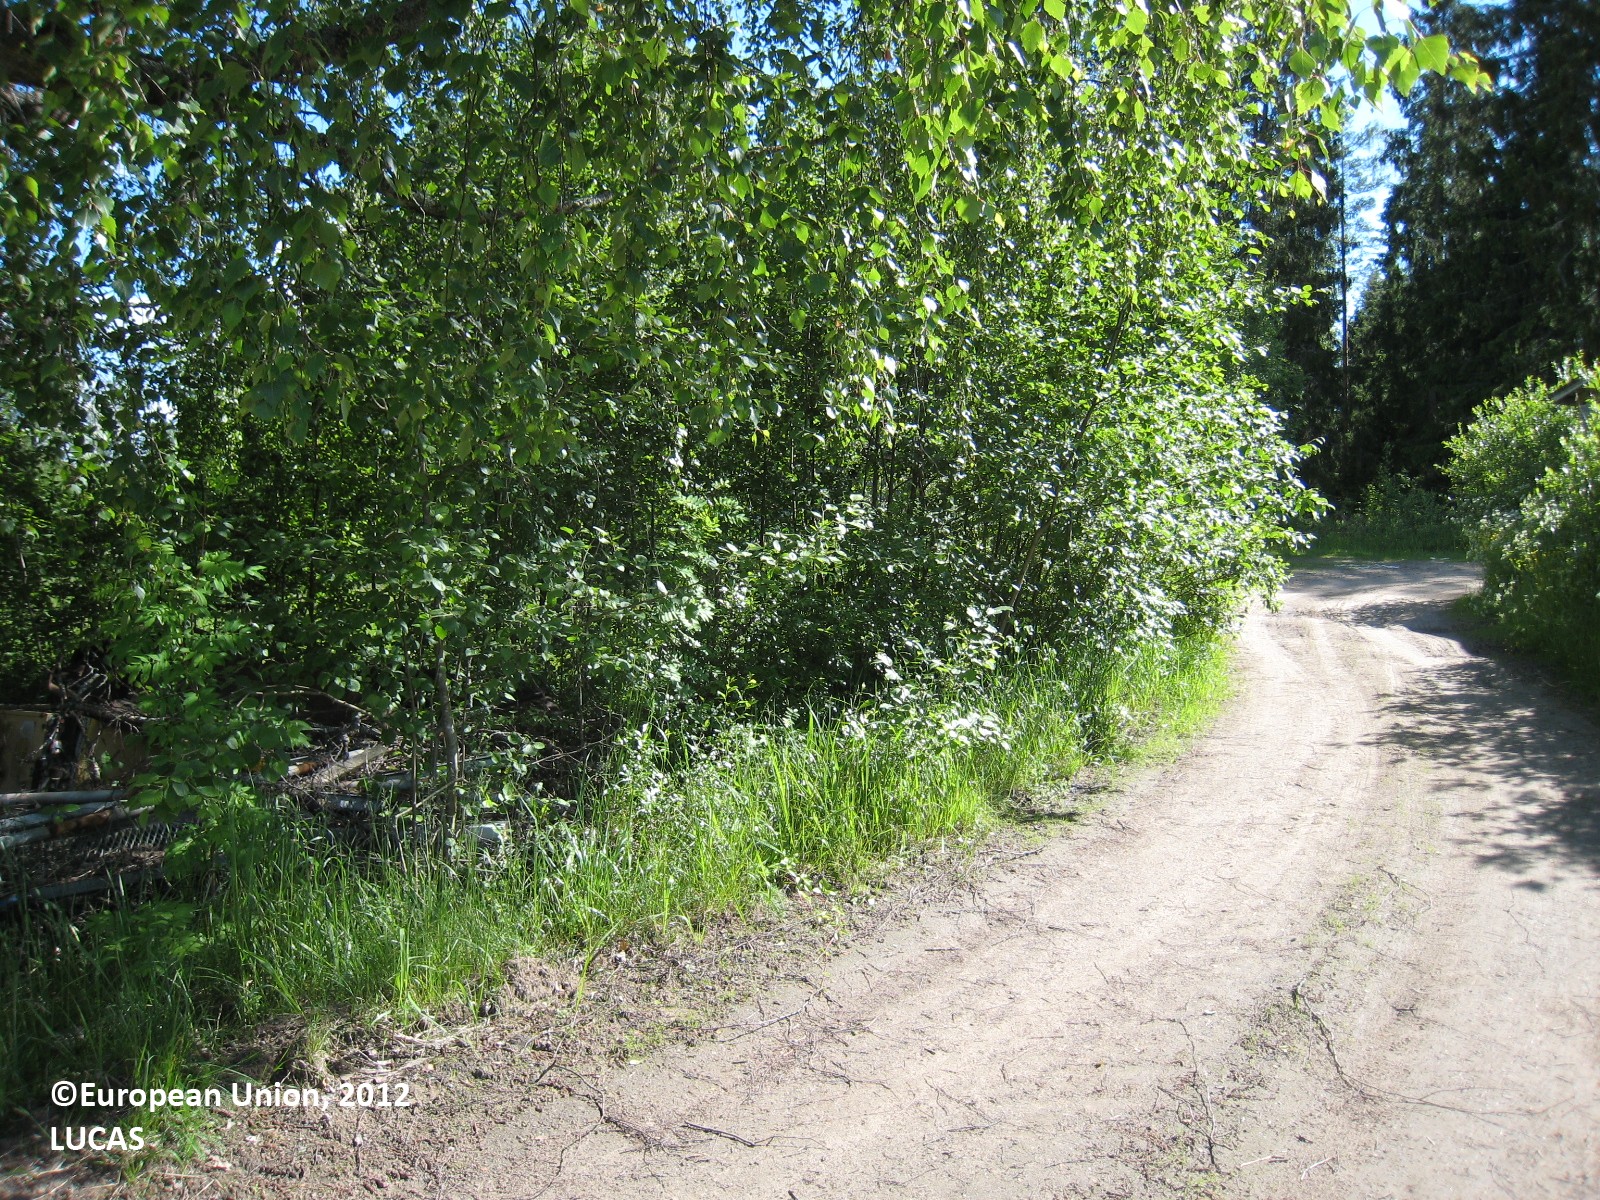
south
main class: Grassland
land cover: Grassland without tree/shrub cover
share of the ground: > 75 %
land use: Agriculture (excluding fallow land and kitchen gardens)
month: June
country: FI
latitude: 62.4832
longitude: 26.3734
